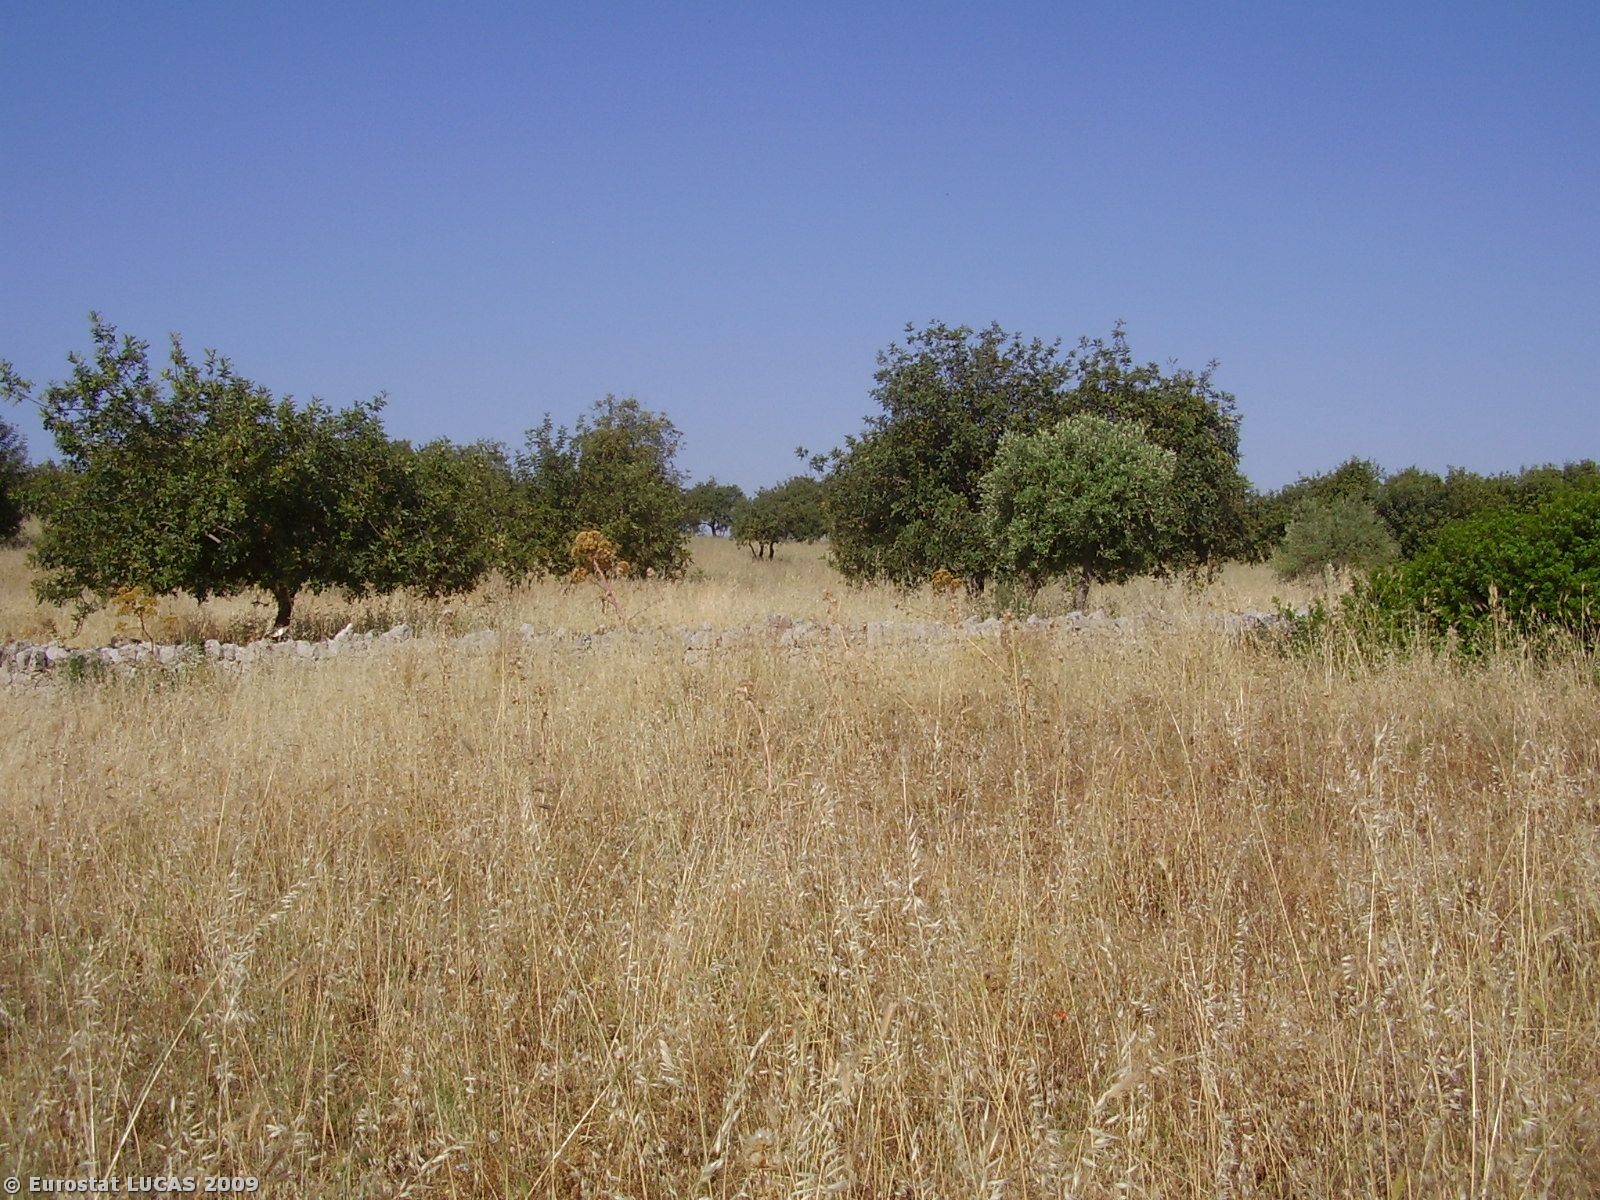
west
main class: Grassland
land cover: Spontaneously vegetated surfaces
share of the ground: > 75 %
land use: Fallow land
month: May
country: IT
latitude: 36.8545
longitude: 14.9516
